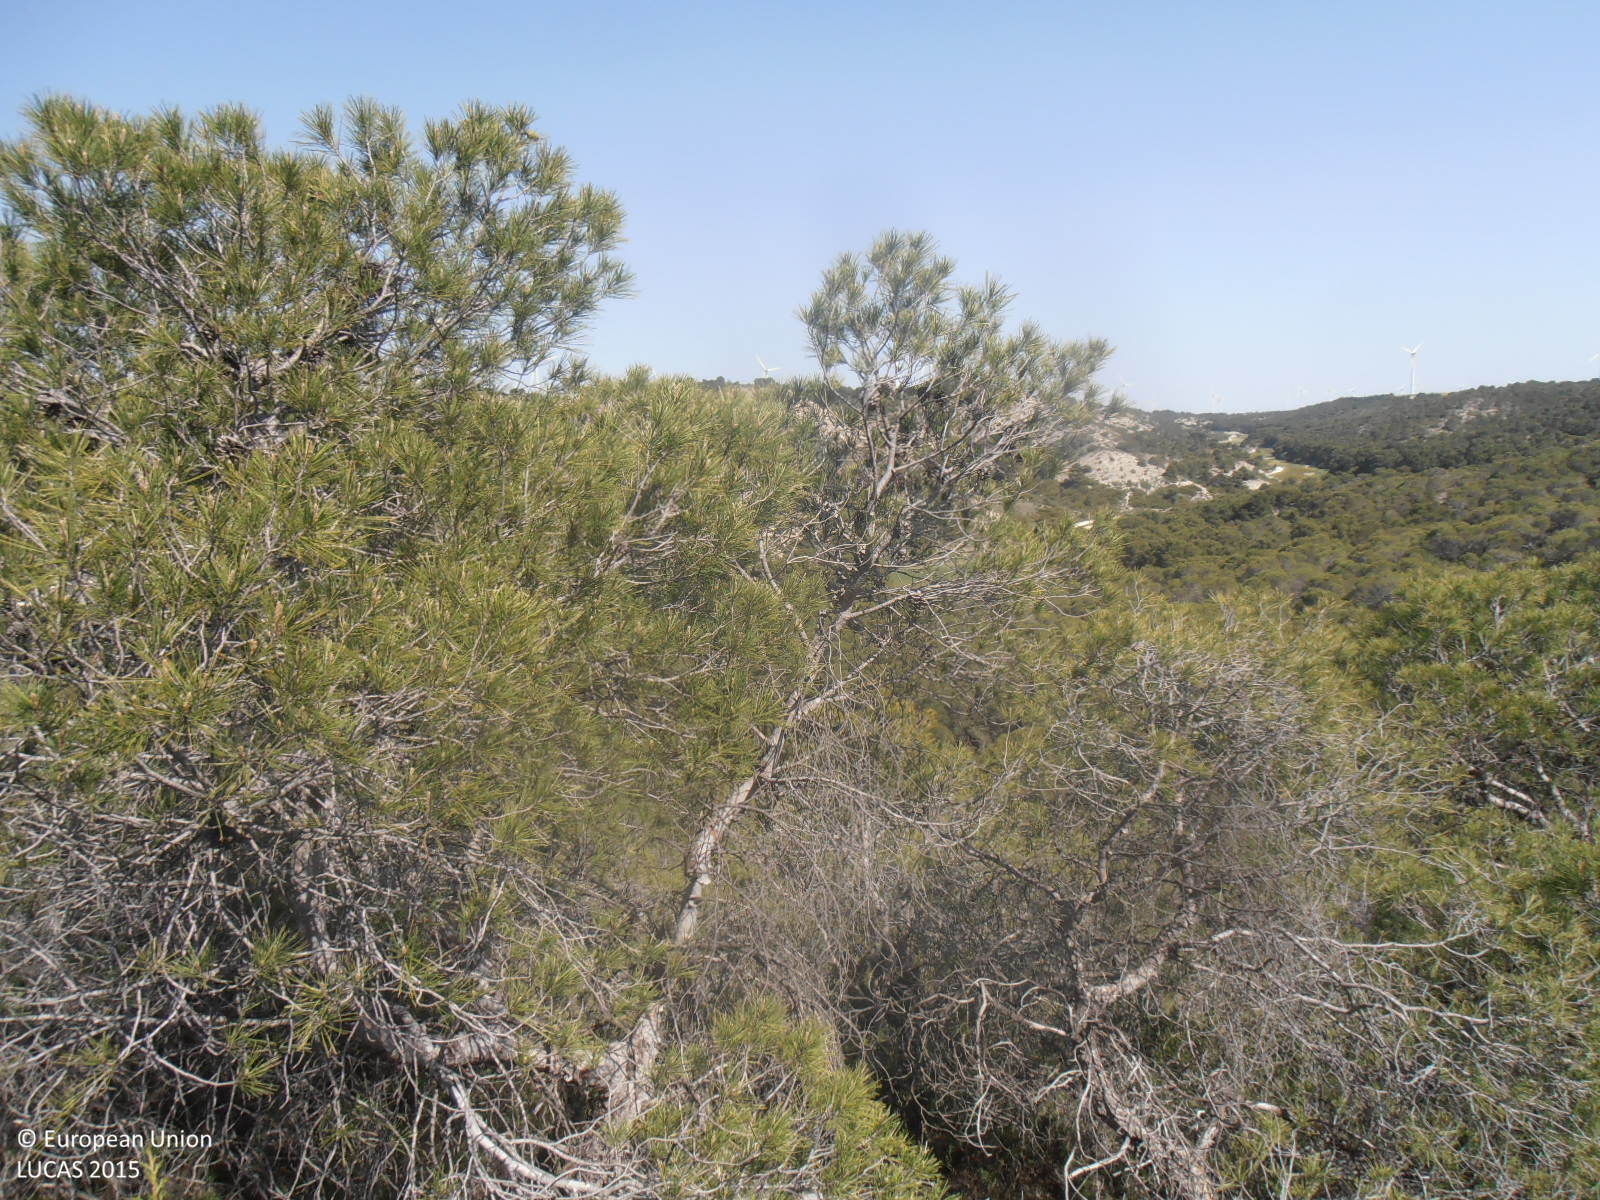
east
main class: Woodland
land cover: Pine dominated coniferous woodland
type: coniferous forest of the mediterranean region
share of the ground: 50 - 75 %
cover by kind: coniferous forest trees 80 %, shrubs 10 %, consolidated bare surface 10 %
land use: Forestry
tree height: > 5 m
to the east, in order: Pine dominated coniferous woodland; Durum wheat
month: May
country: ES
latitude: 41.4931
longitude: -0.9570
